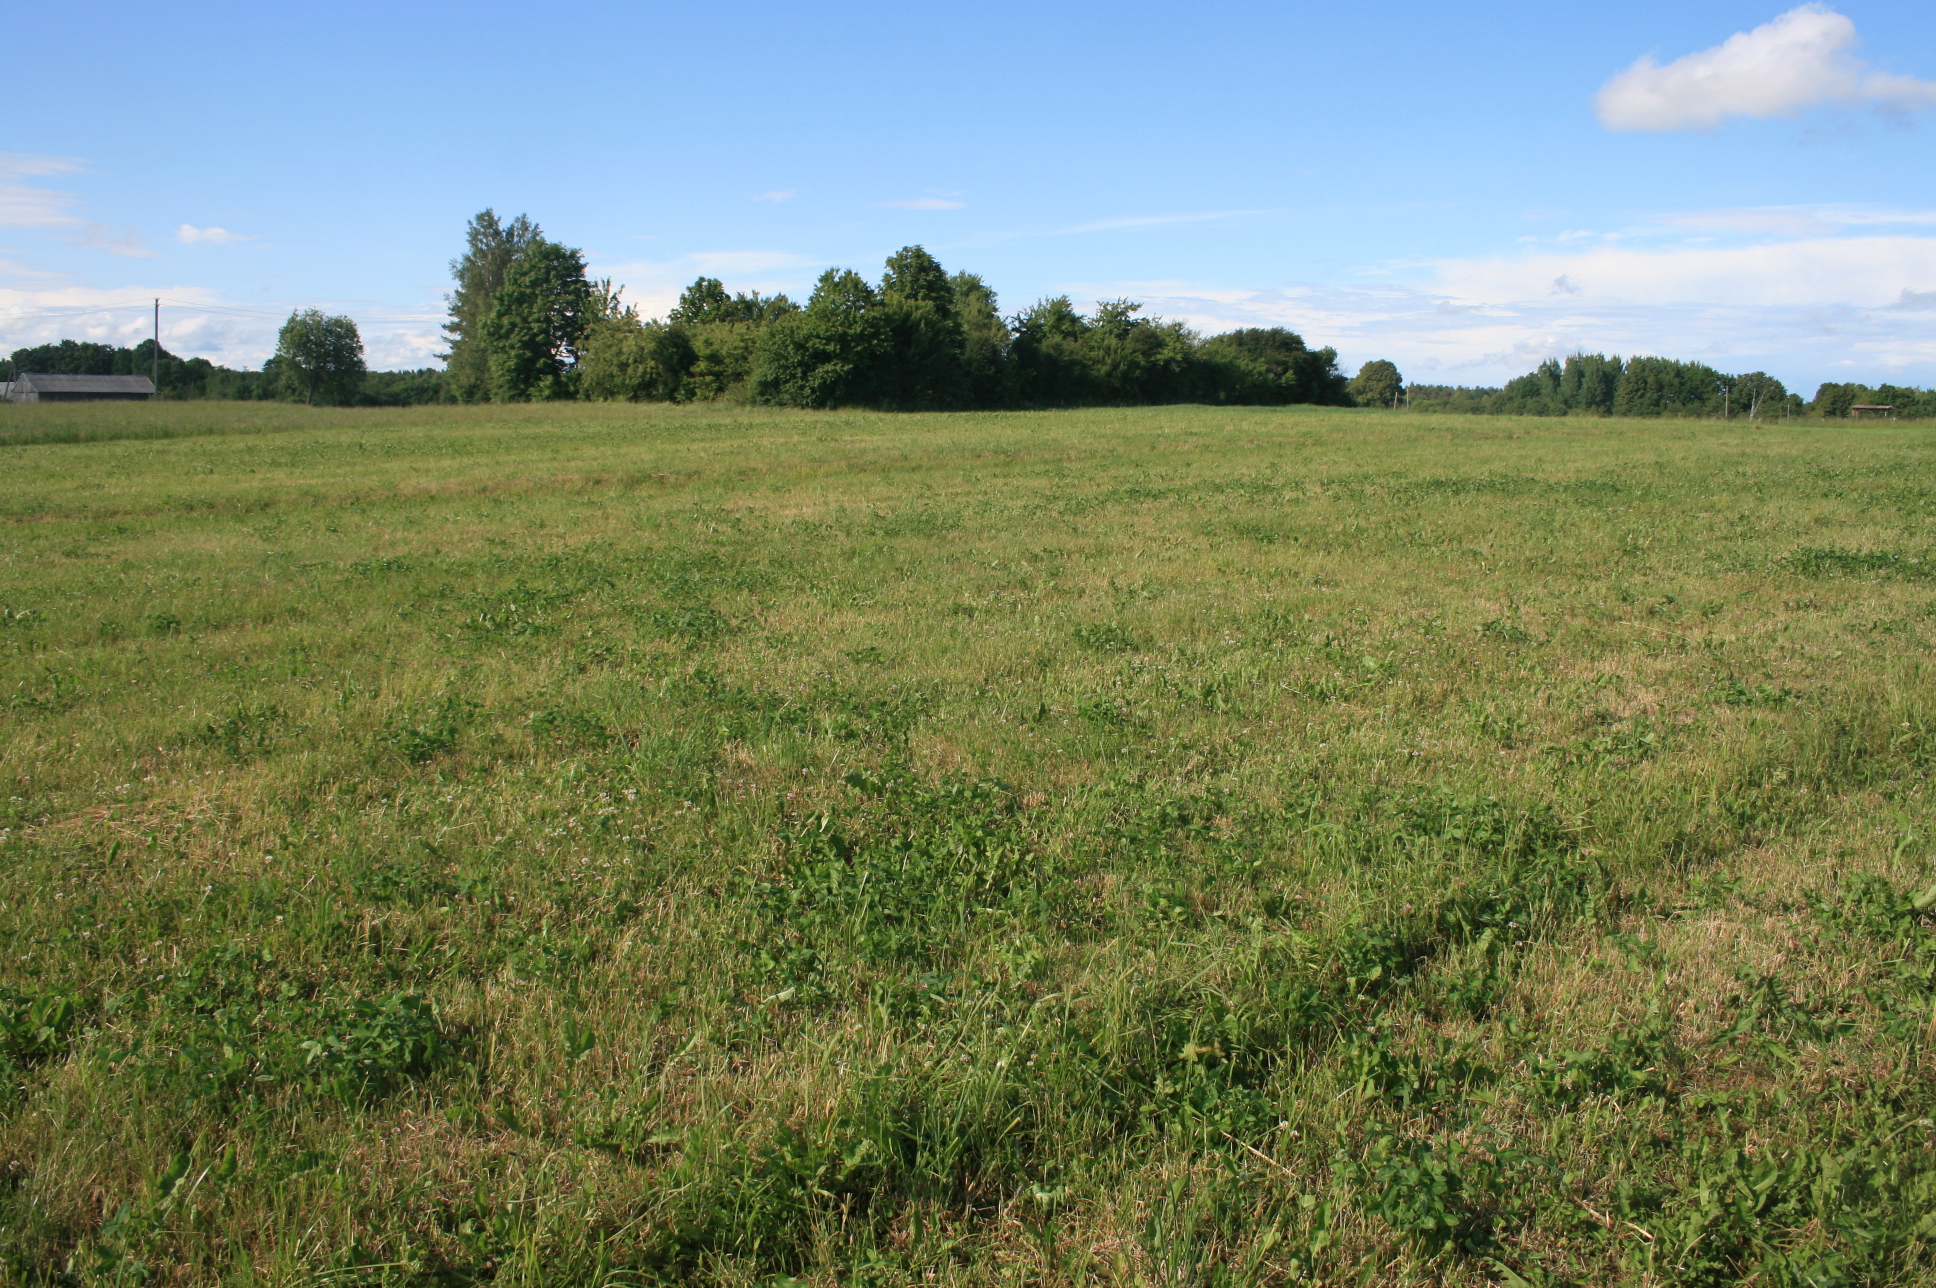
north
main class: Grassland
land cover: Grassland without tree/shrub cover
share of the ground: > 75 %
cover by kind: herbaceous plants 100 %
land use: Agriculture (excluding fallow land and kitchen gardens)
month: June
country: LT
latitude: 55.4971
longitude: 22.1652
